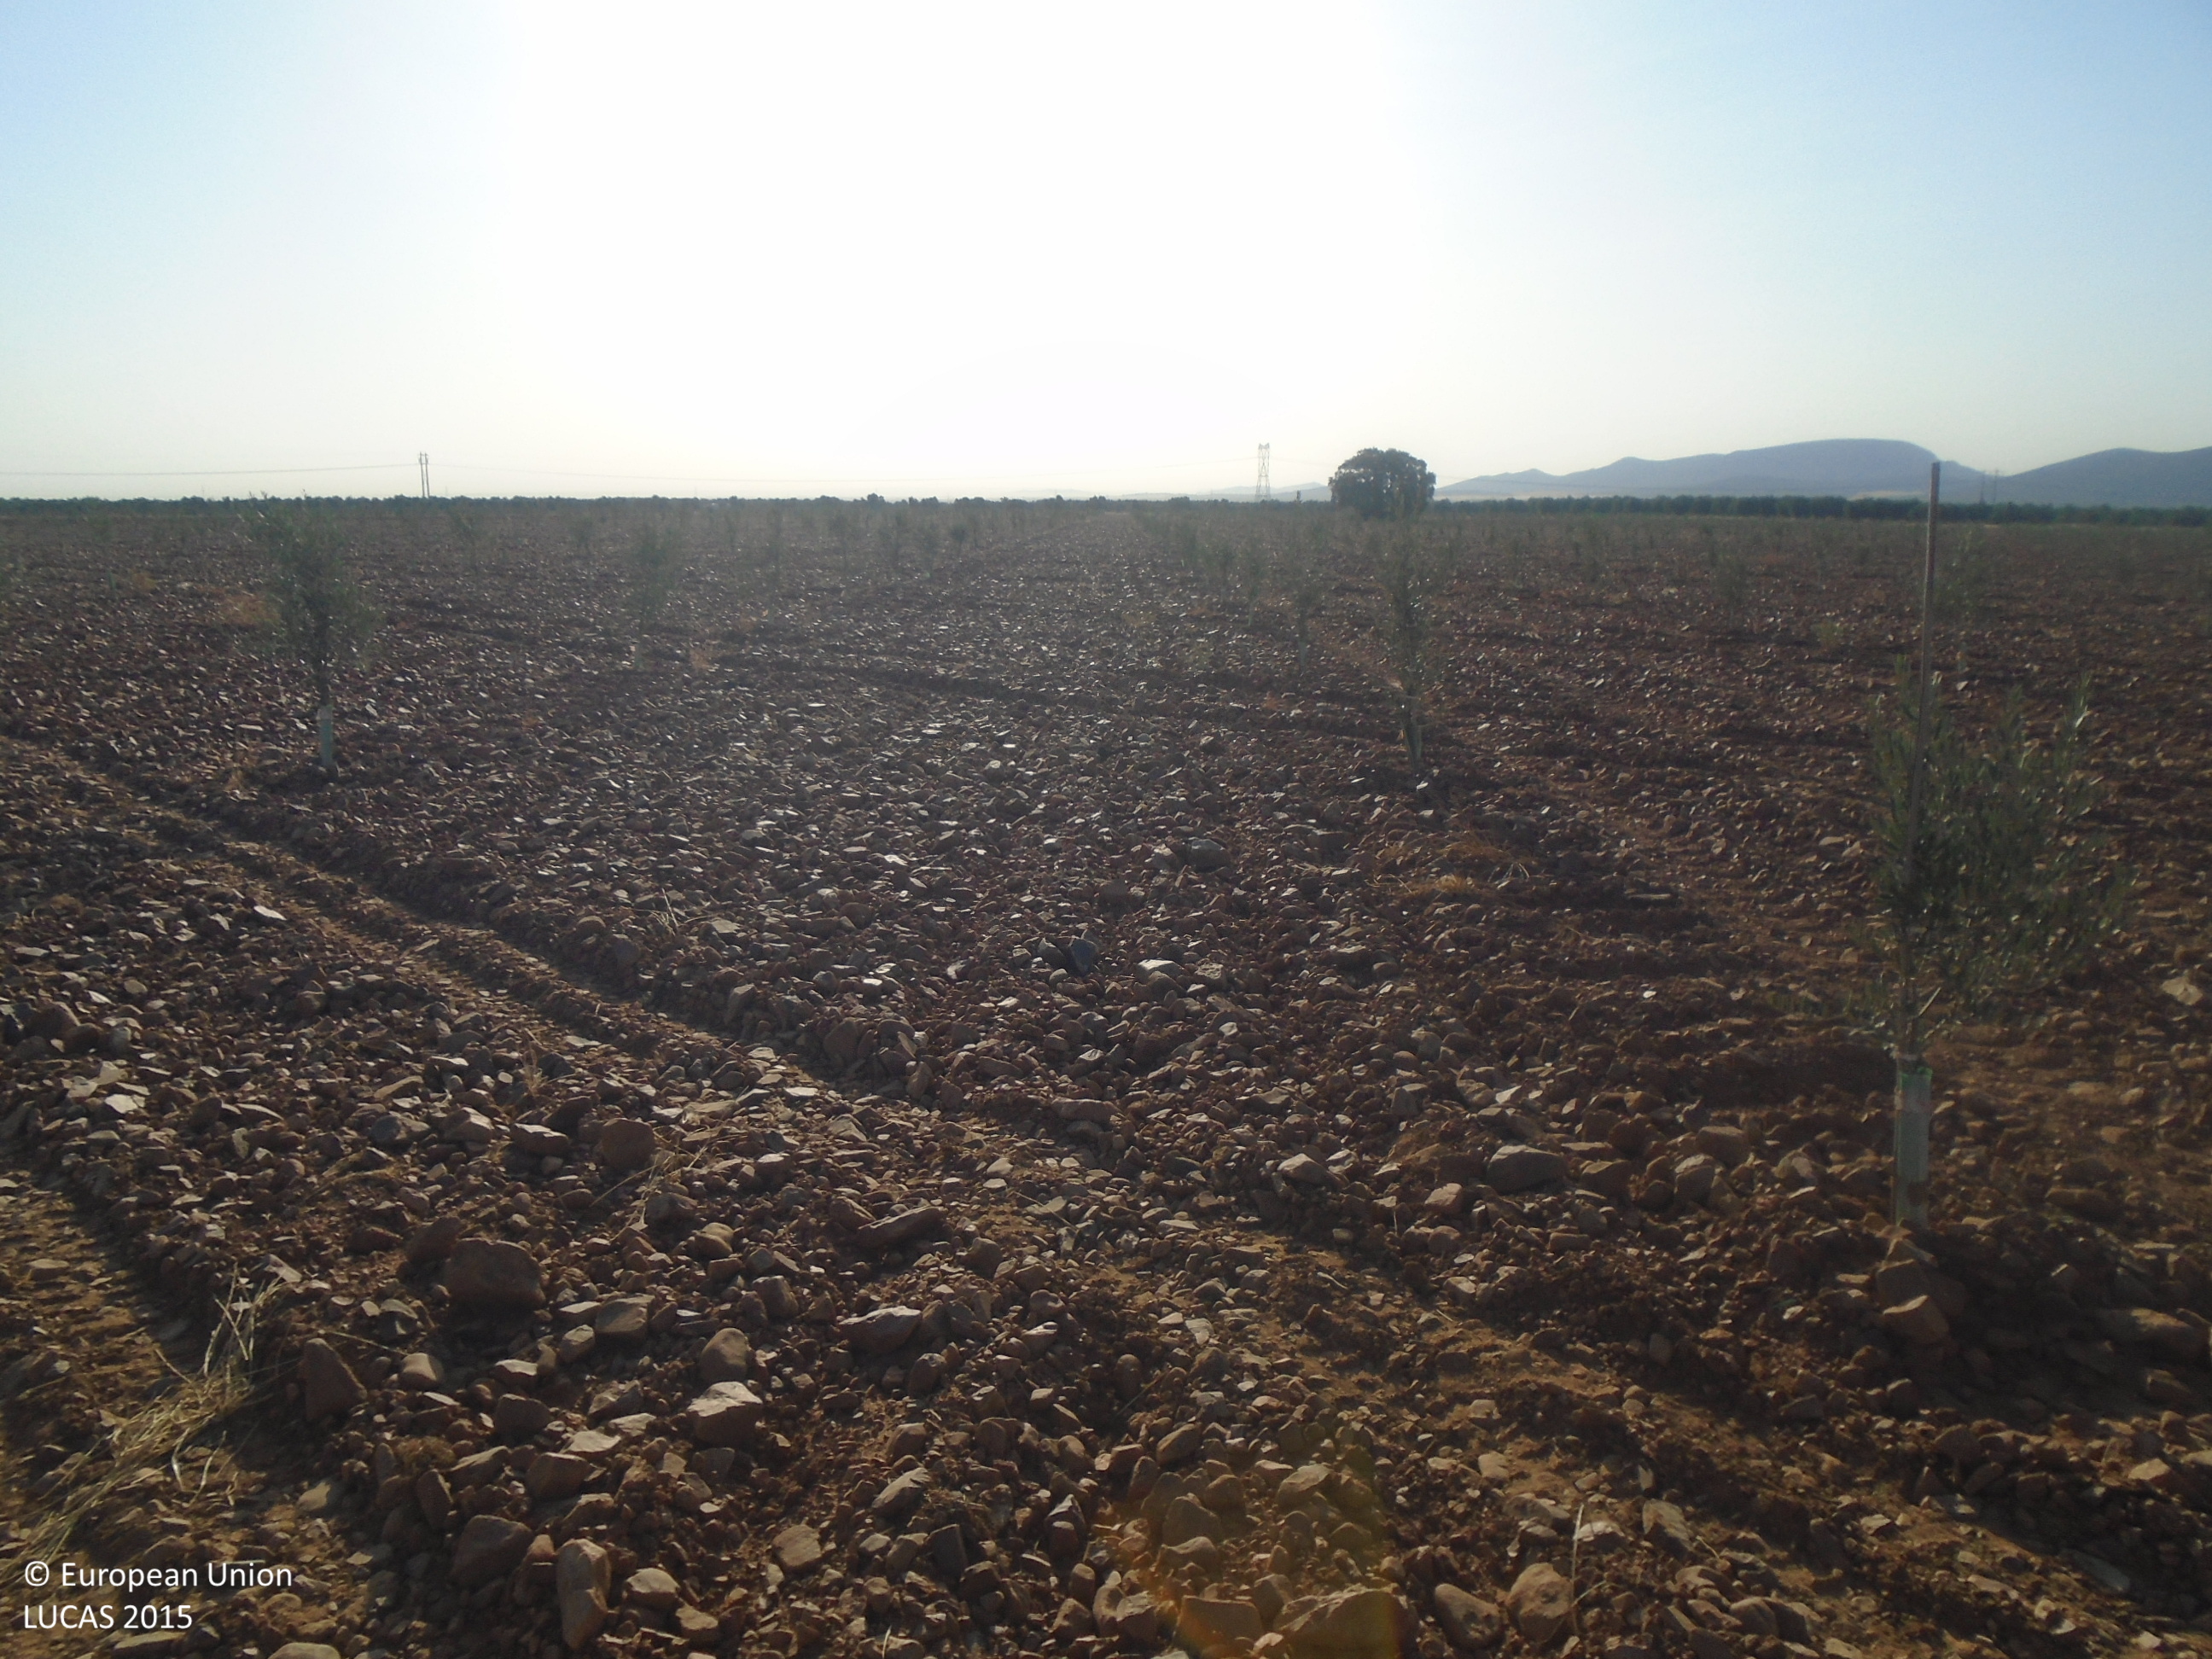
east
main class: Cropland
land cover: Olive groves
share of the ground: < 10 %
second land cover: Other bare soil
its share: > 75 %
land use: Agriculture (excluding fallow land and kitchen gardens)
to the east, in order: Olive groves; Other bare soil; Single bushes/trees; Olive groves
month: July
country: ES
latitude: 39.3457
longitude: -3.5154
